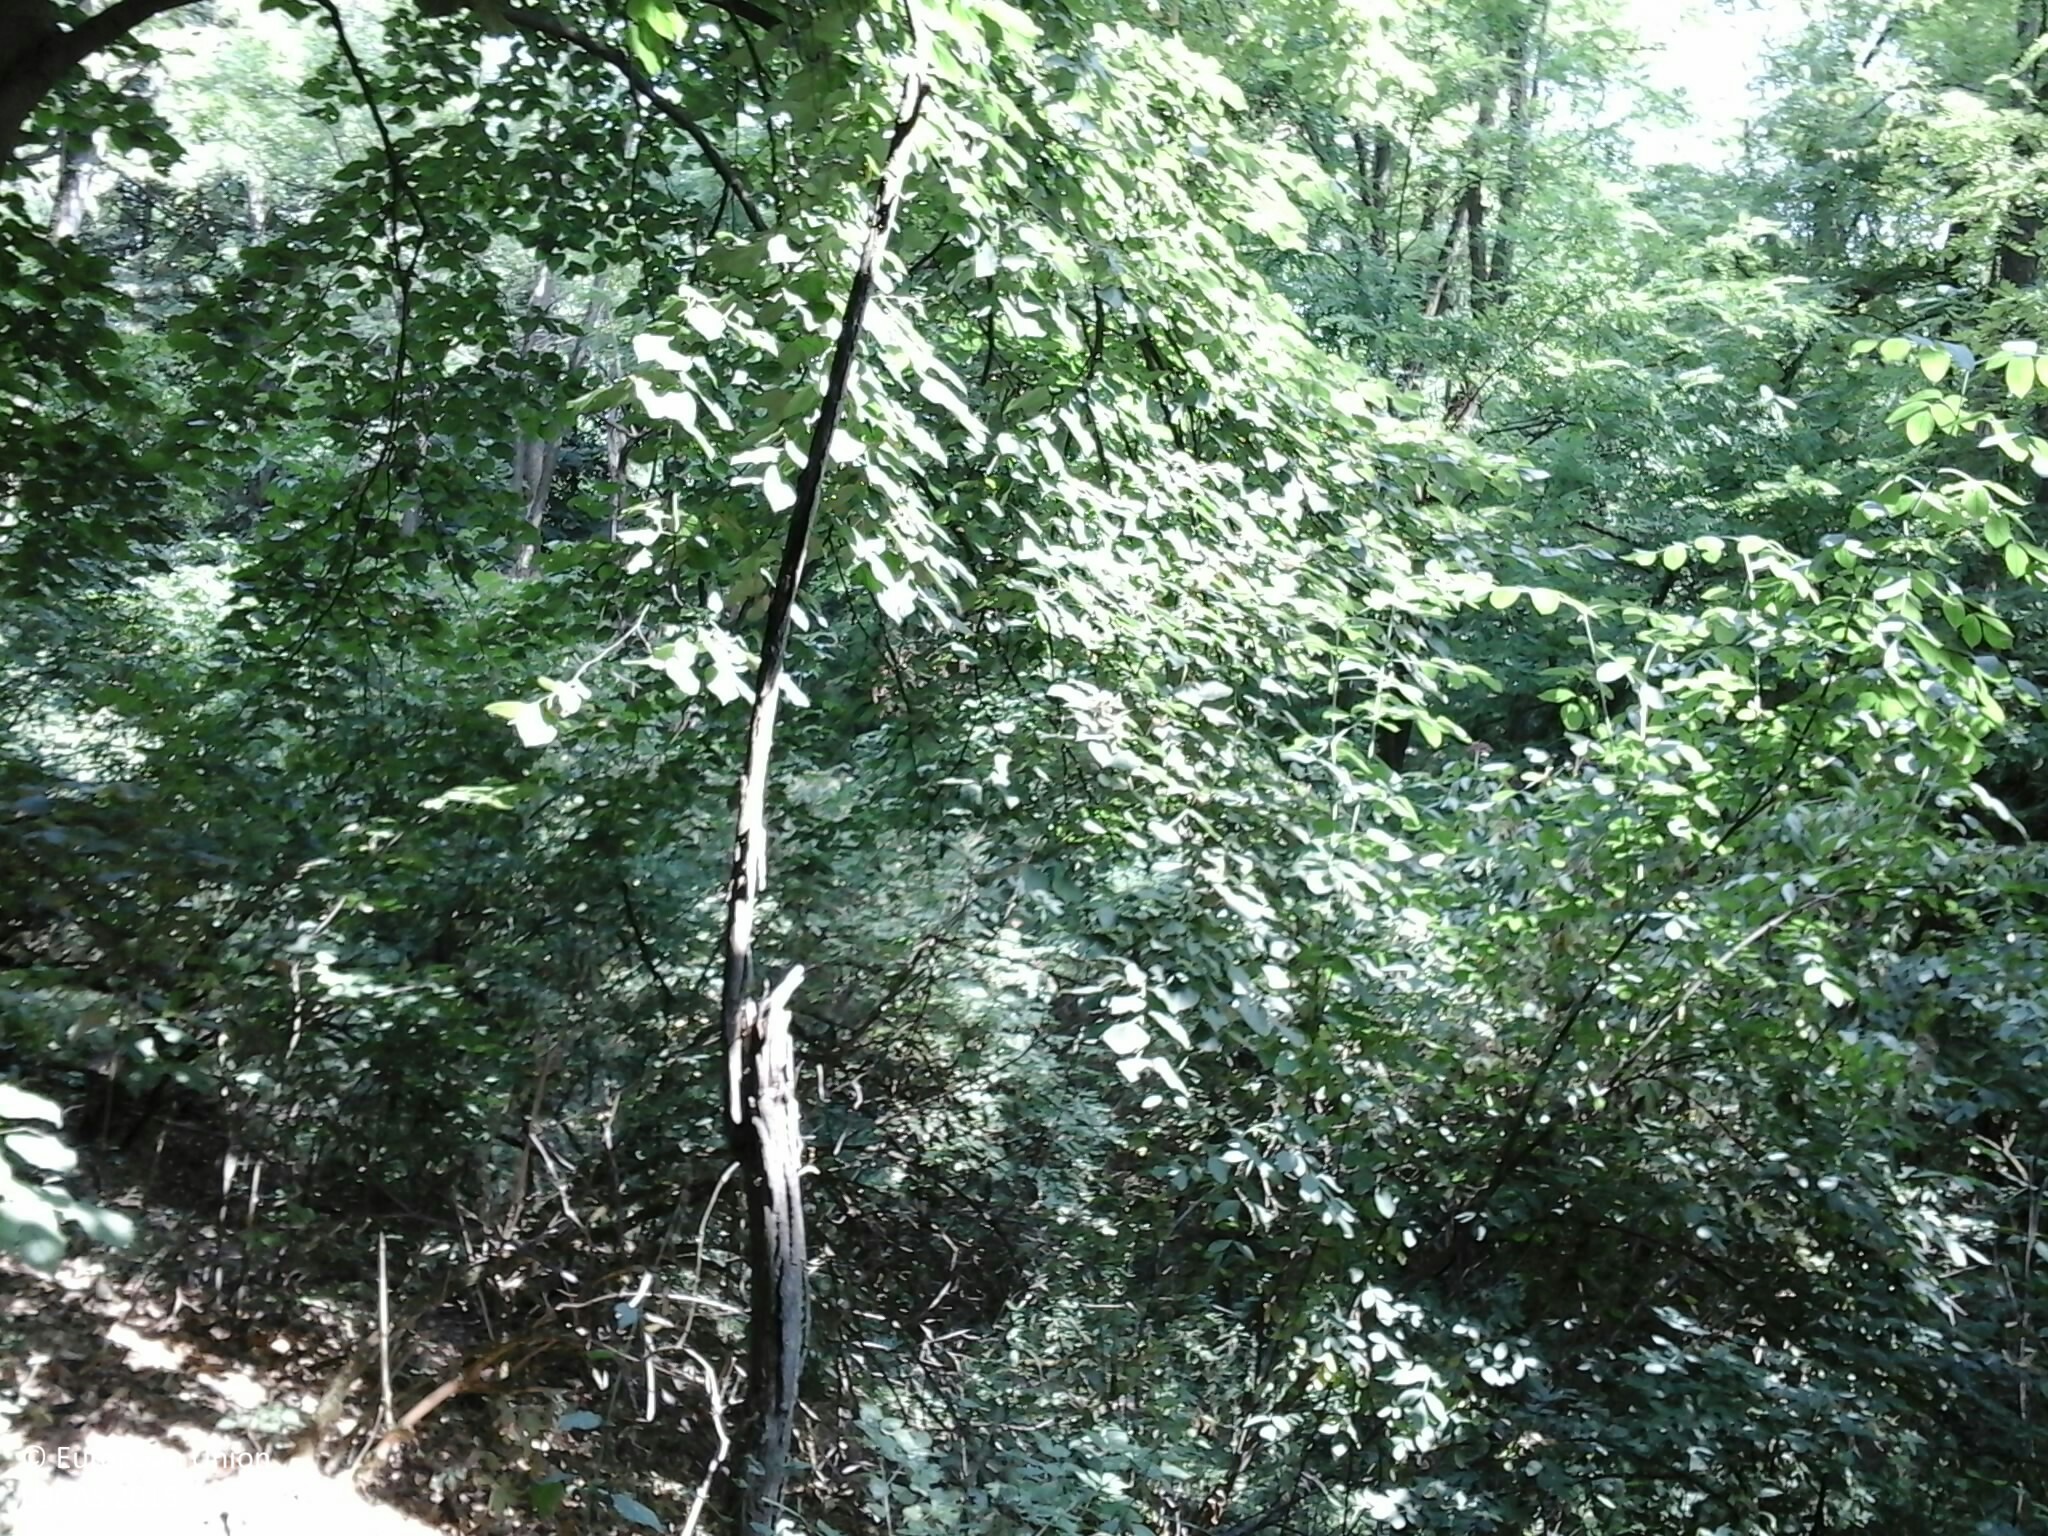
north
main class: Woodland
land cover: Broadleaved woodland
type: mesophytic deciduous forest
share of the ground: > 75 %
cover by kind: broadleaved forest trees 100 %
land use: Forestry
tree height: > 5 m
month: August
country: HU
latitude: 46.7326
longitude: 18.0828
